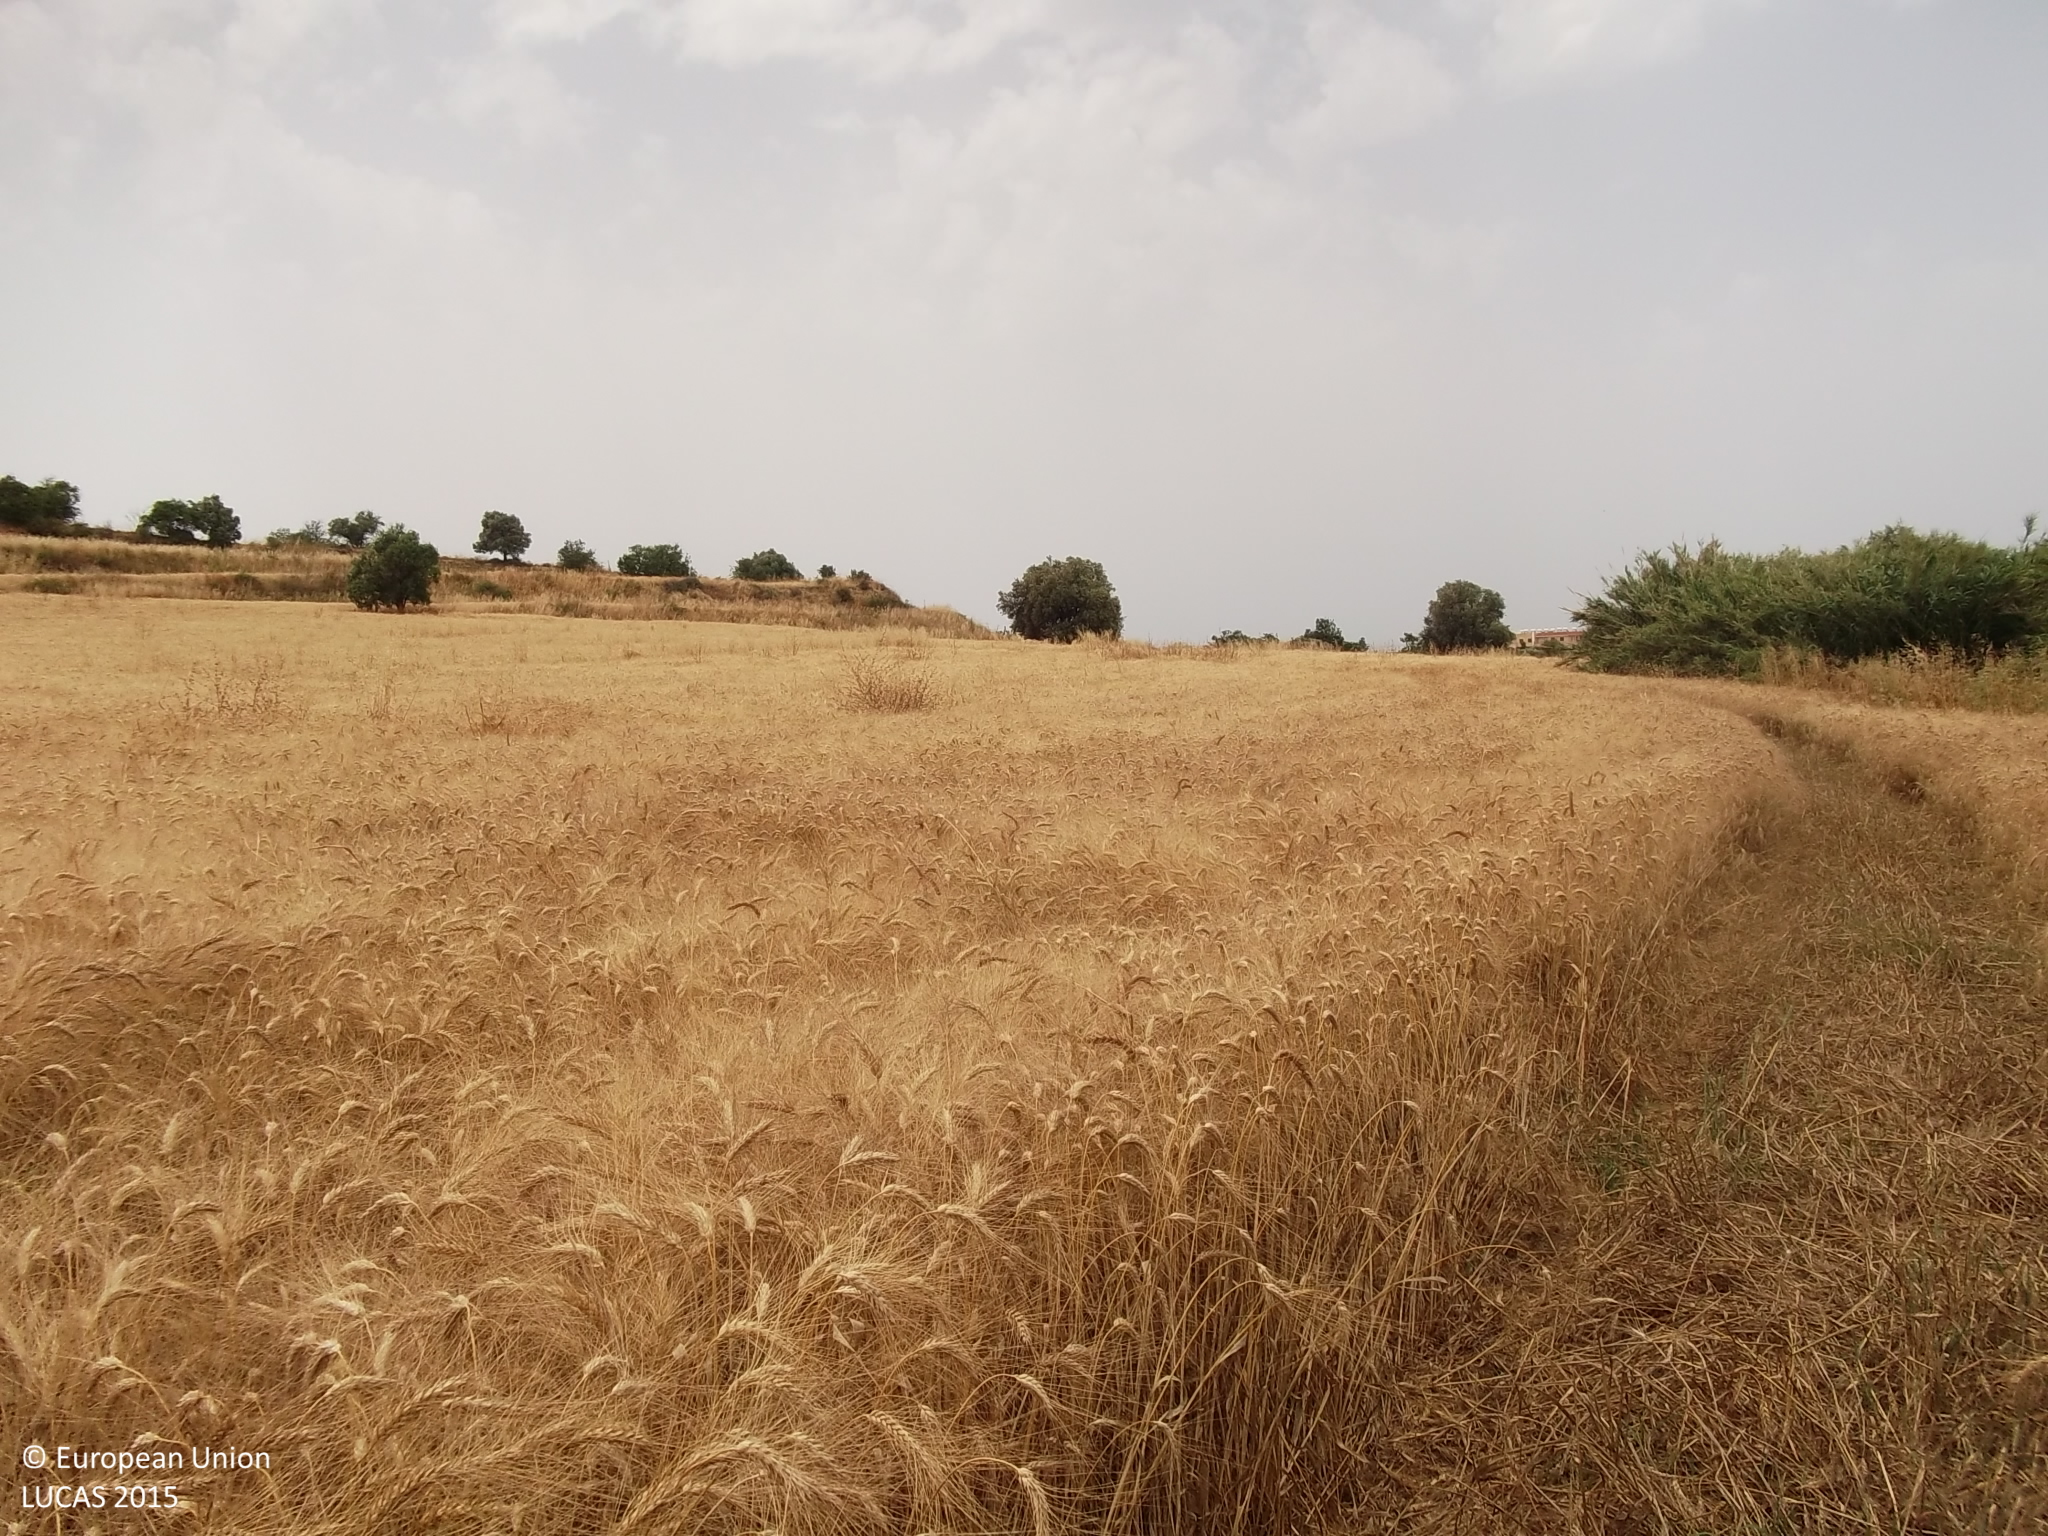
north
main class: Cropland
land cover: Barley
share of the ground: > 75 %
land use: Agriculture (excluding fallow land and kitchen gardens)
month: May
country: CY
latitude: 35.0297
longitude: 32.4367
